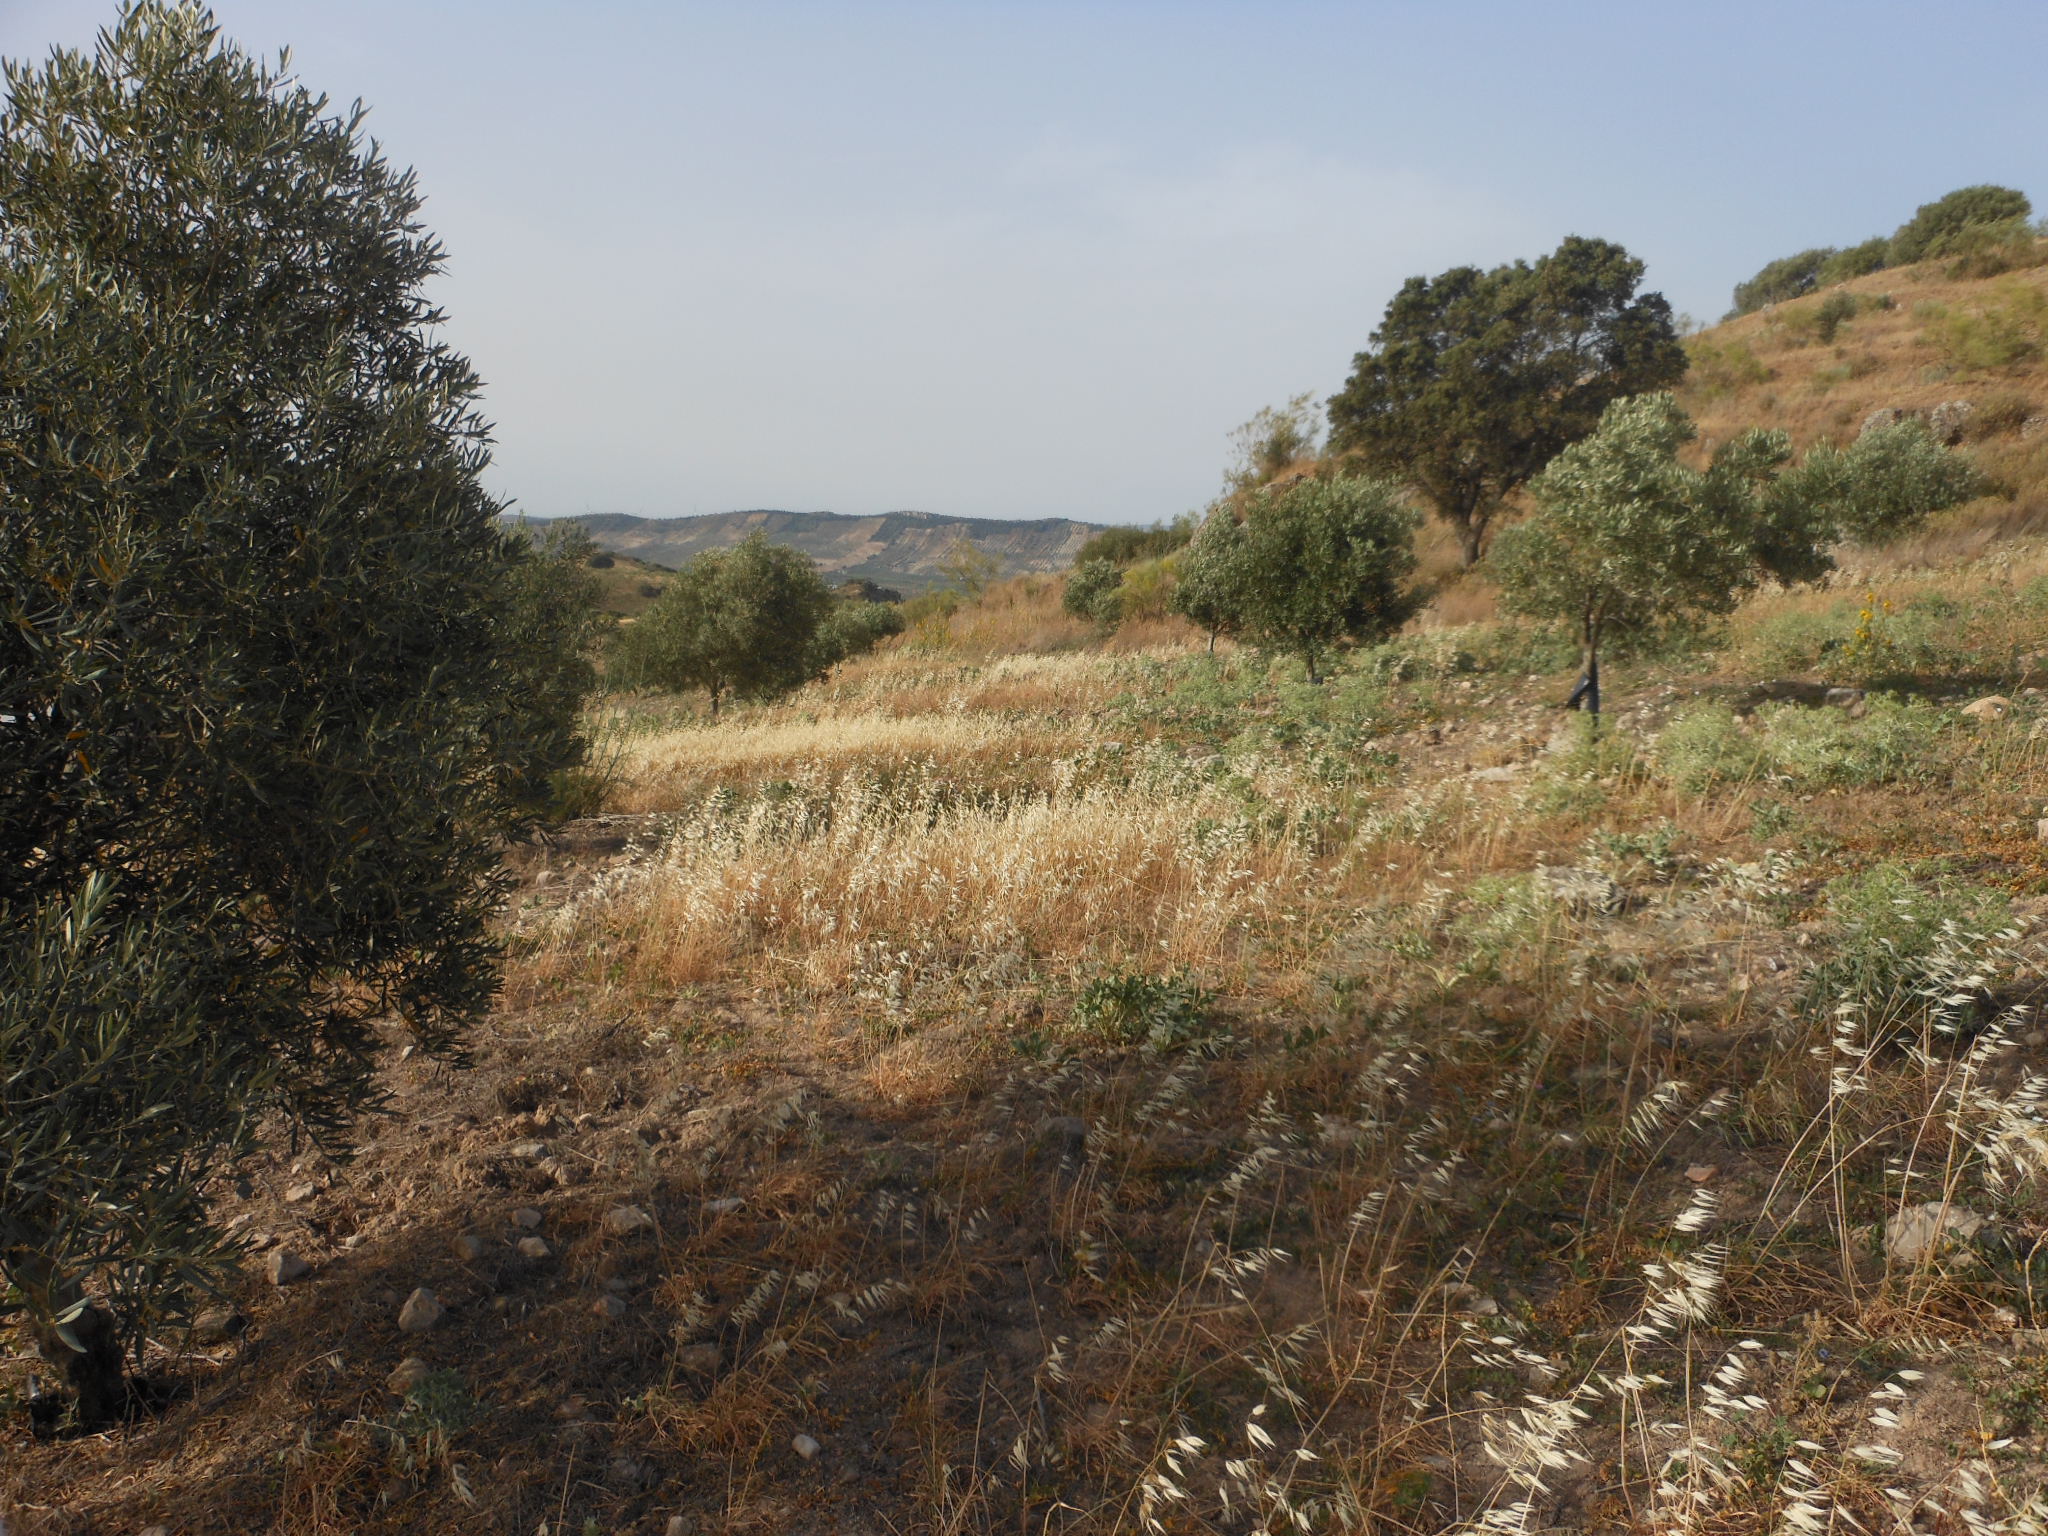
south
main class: Cropland
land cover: Olive groves
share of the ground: 10 - 25 %
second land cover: Spontaneously vegetated surfaces
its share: 50 - 75 %
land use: Agriculture (excluding fallow land and kitchen gardens)
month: June
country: ES
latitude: 37.1342
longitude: -5.0326
